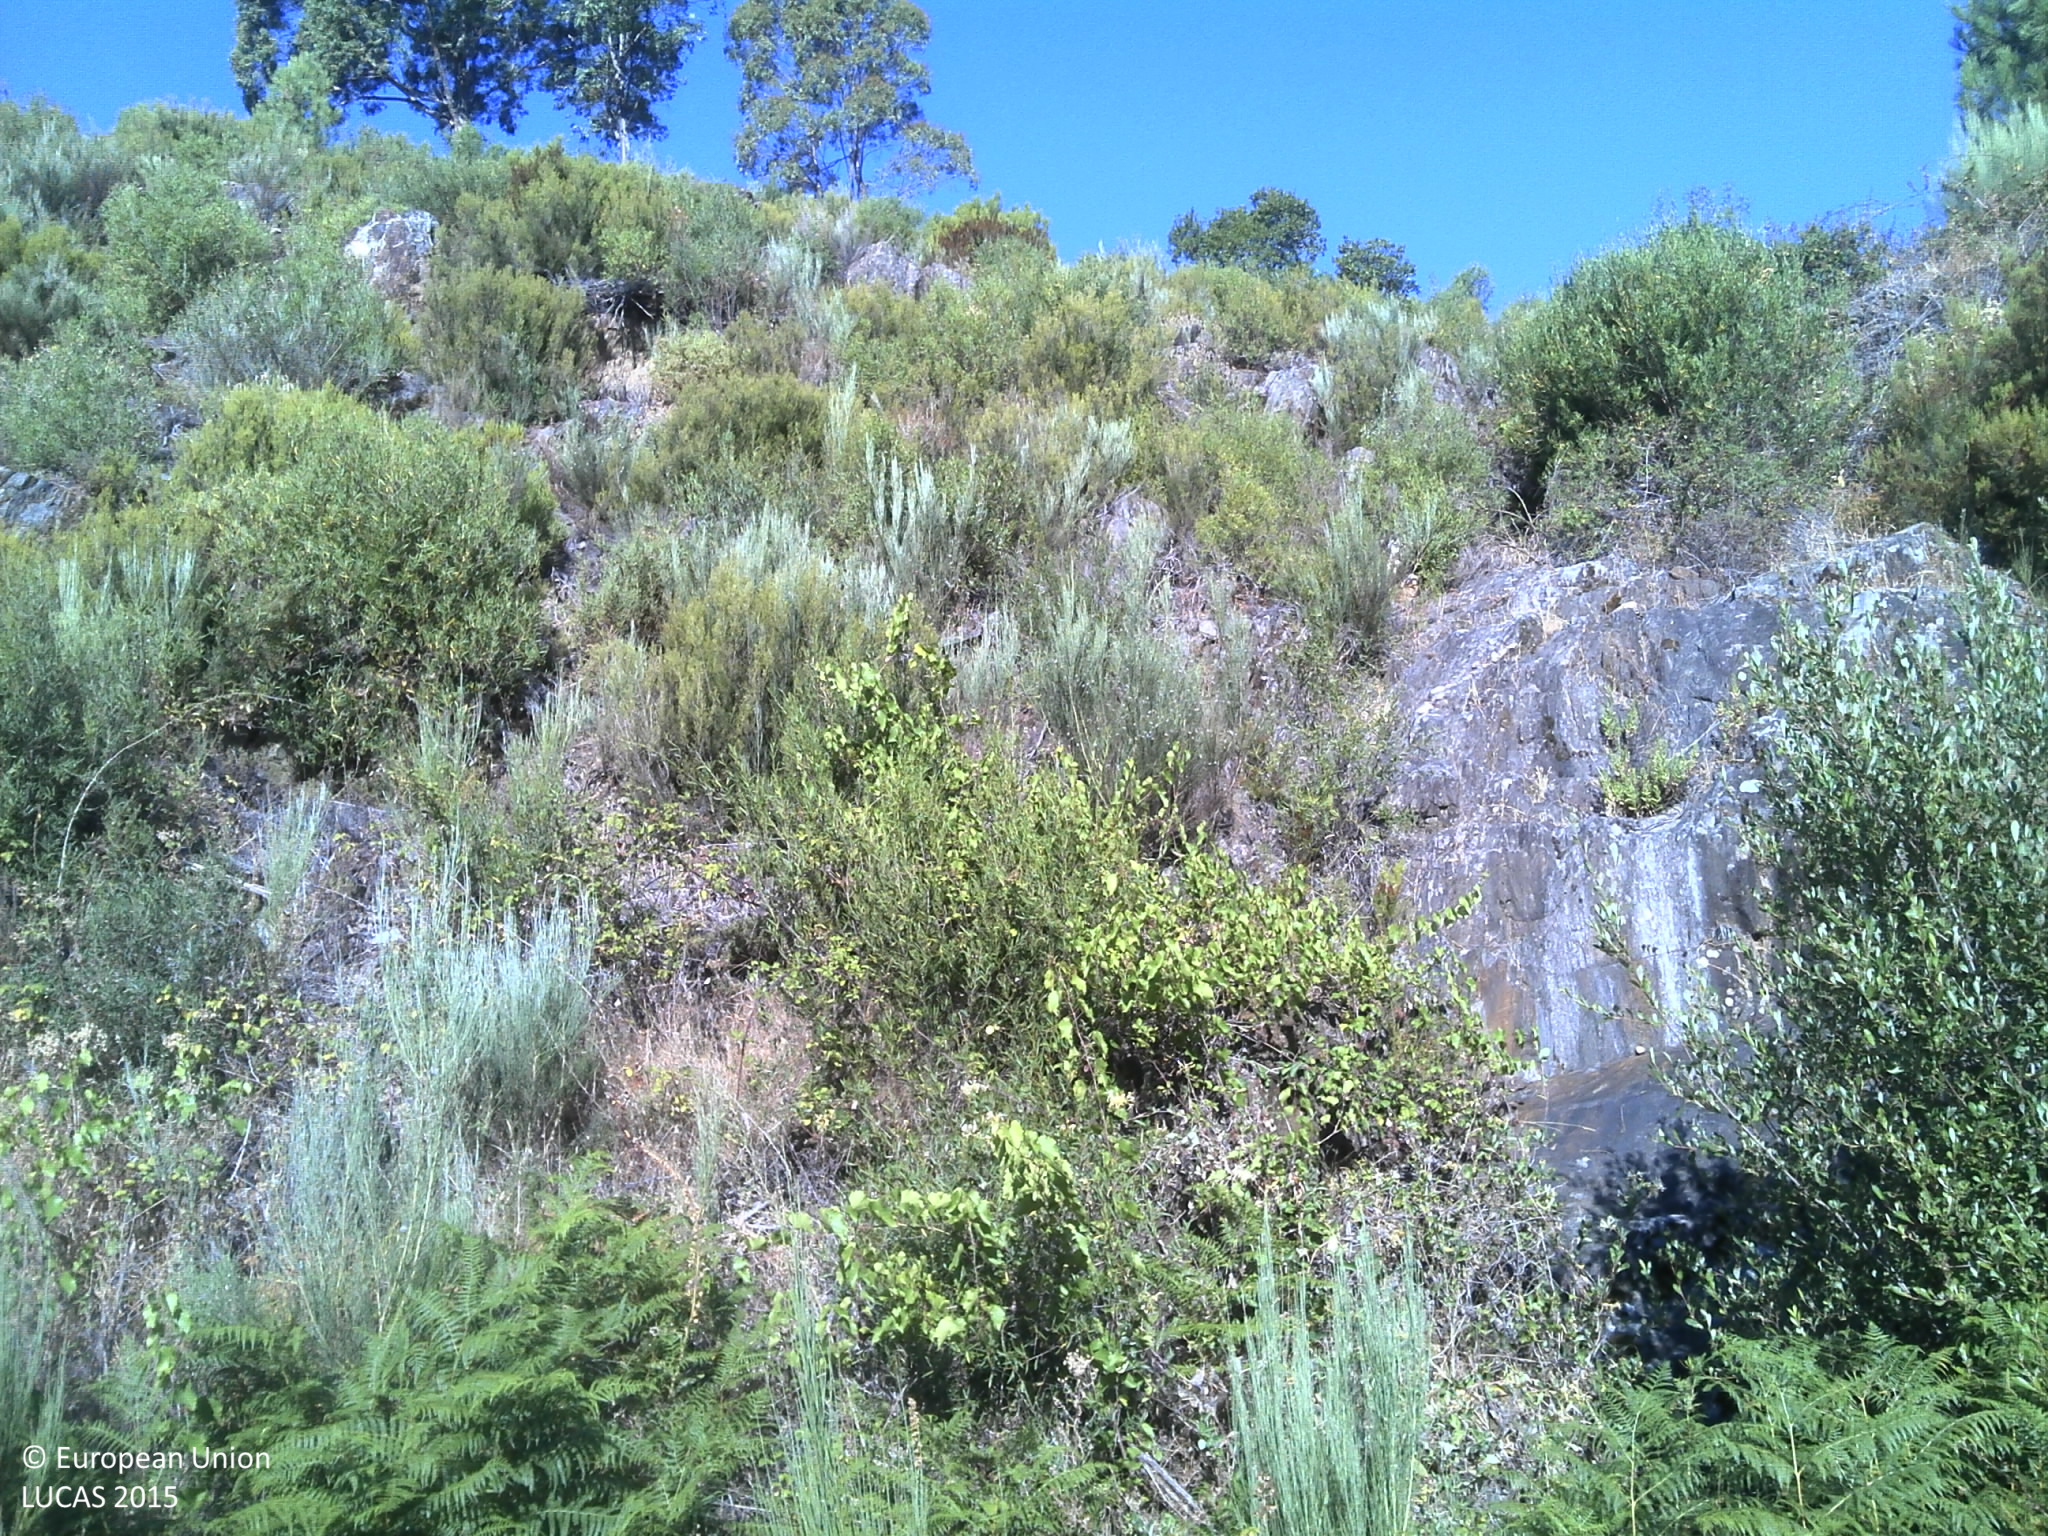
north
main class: Shrubland
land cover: Shrubland with sparse tree cover
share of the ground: 50 - 75 %
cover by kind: shrubs 70 %, unconsolidated bare surface 20 %, coniferous forest trees 5 %, consolidated bare surface 5 %
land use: Abandoned areas
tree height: > 5 m
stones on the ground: 10 - 25 %
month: July
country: PT
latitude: 40.2389
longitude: -7.6597
